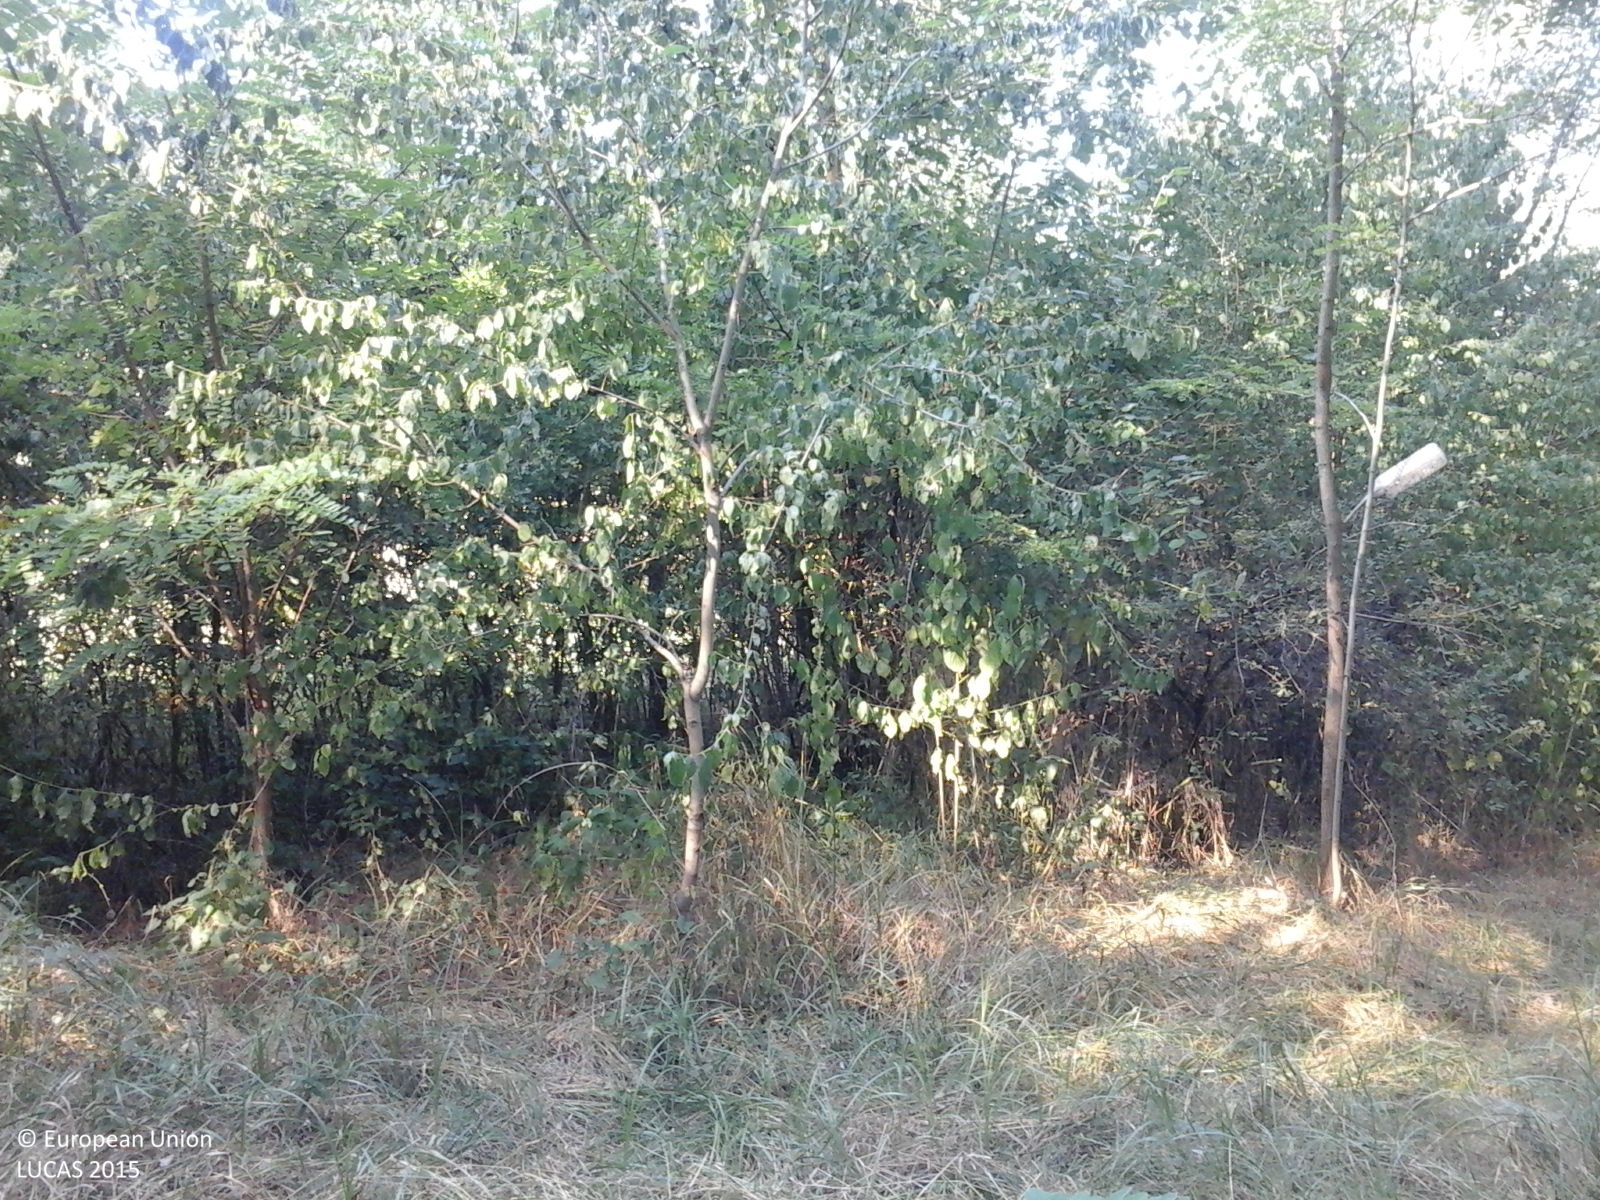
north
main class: Woodland
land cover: Broadleaved woodland
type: acidophilous oak and oak-birch forest
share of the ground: > 75 %
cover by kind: broadleaved forest trees 100 %
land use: Forestry
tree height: > 5 m
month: August
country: RO
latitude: 44.4146
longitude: 23.6307
